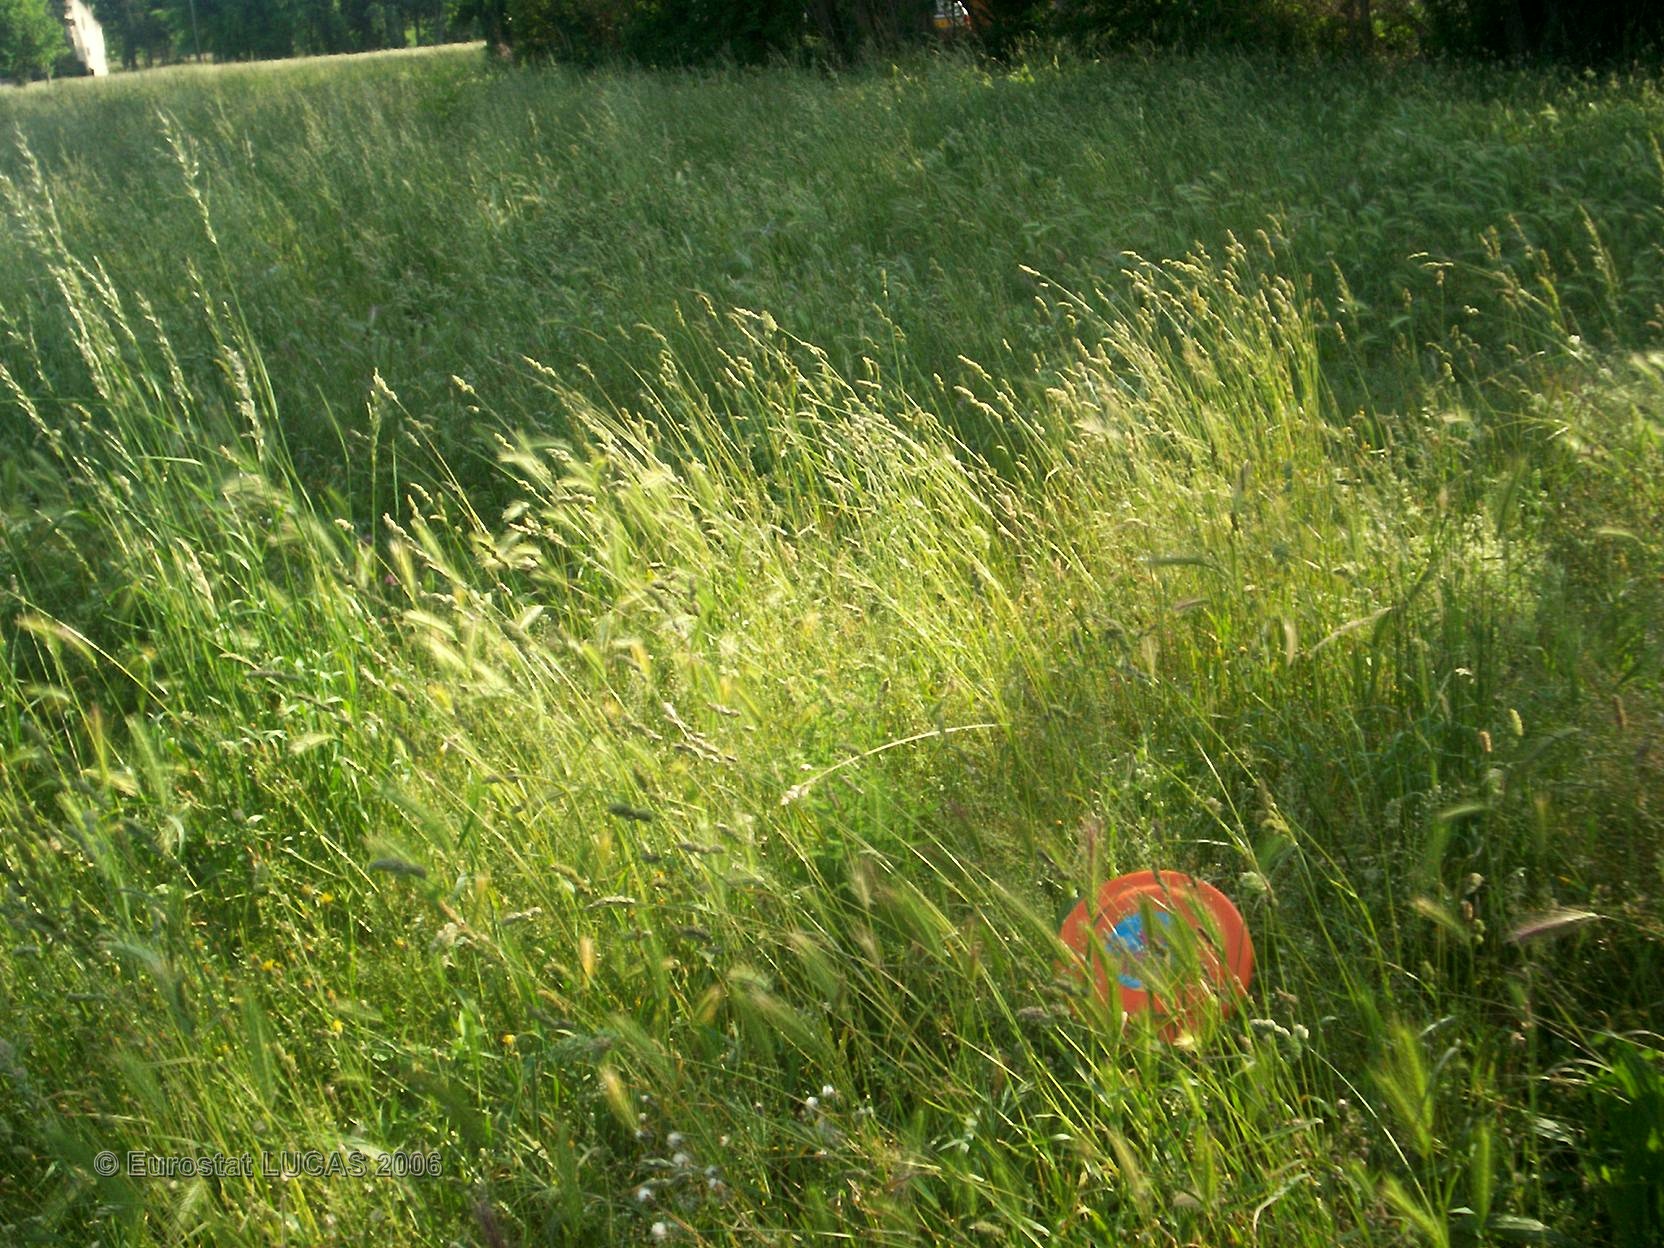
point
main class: Grassland
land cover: Grassland without tree/shrub cover
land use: Agriculture (excluding fallow land and kitchen gardens)
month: May
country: FR
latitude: 43.9355
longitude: 4.8886
